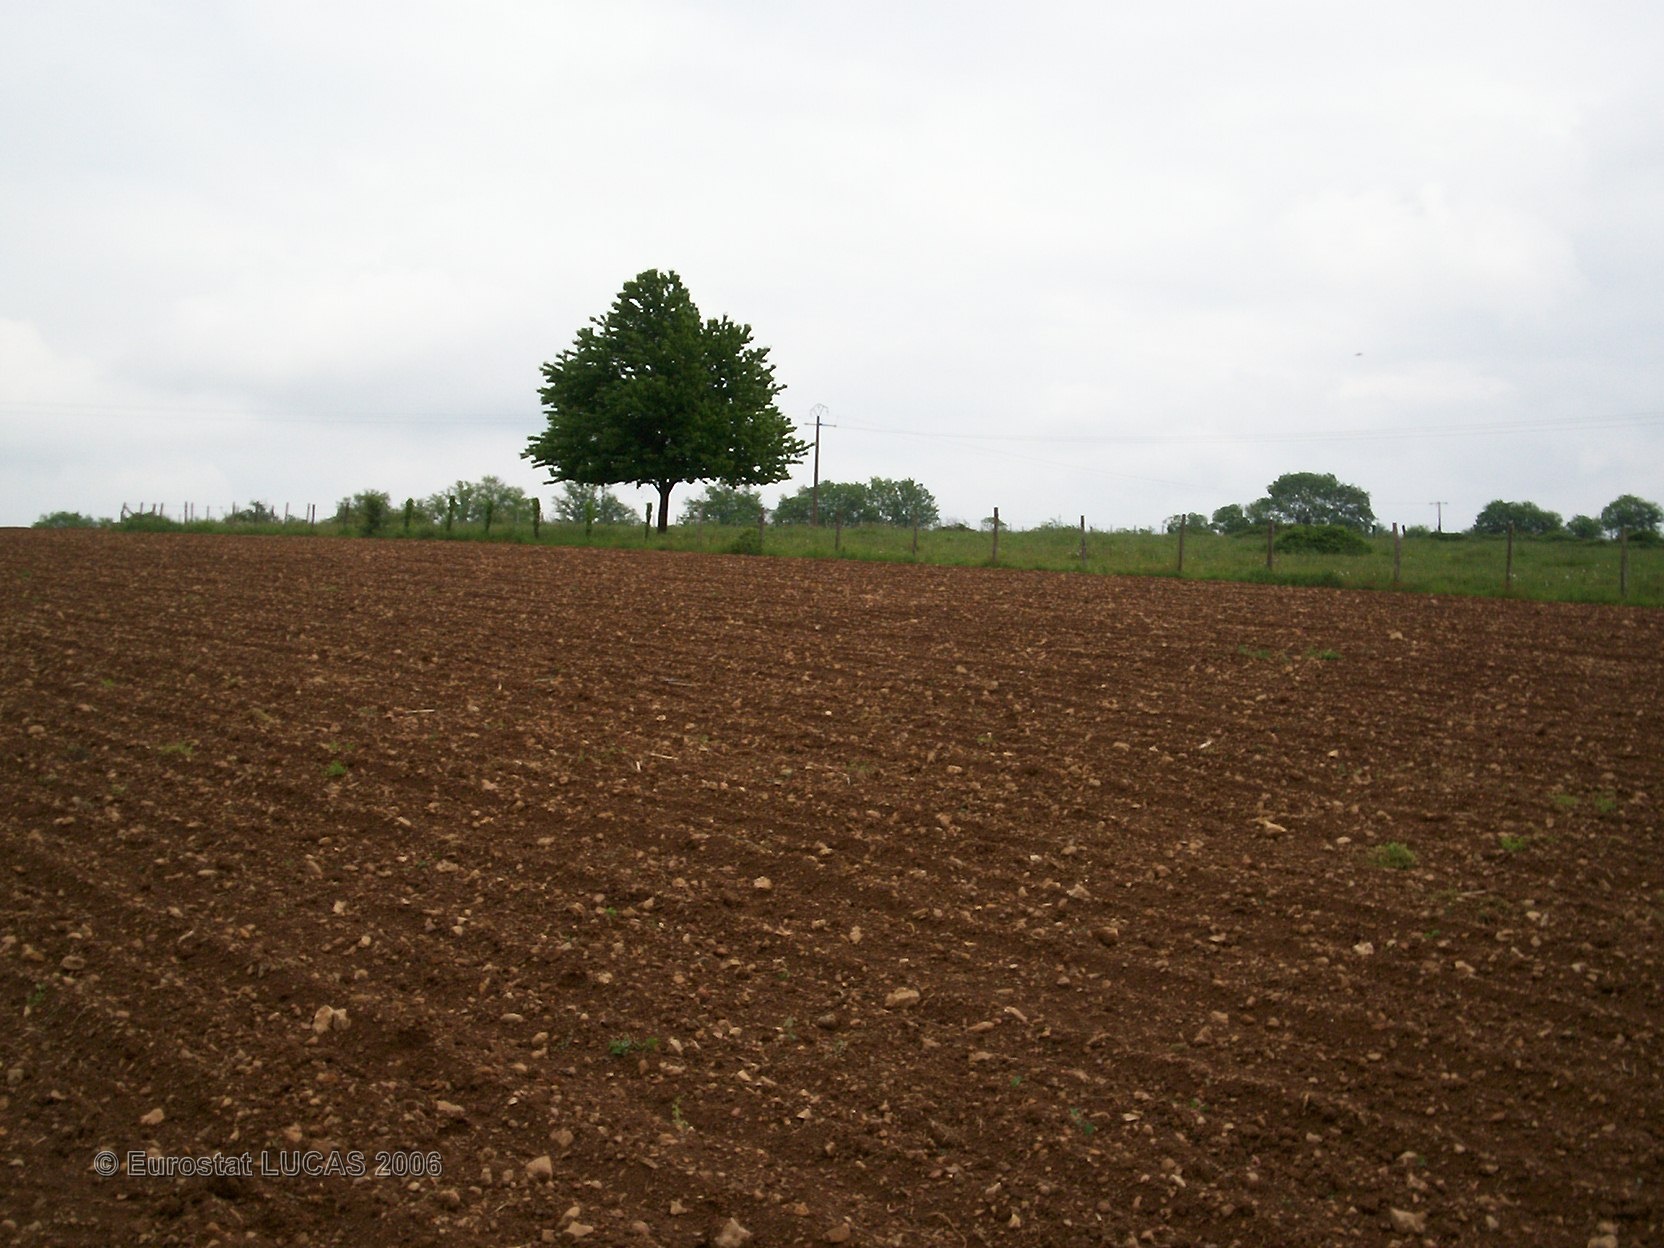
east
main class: Cropland
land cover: Maize
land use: Agriculture (excluding fallow land and kitchen gardens)
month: May
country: FR
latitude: 45.7272
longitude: 0.4902
